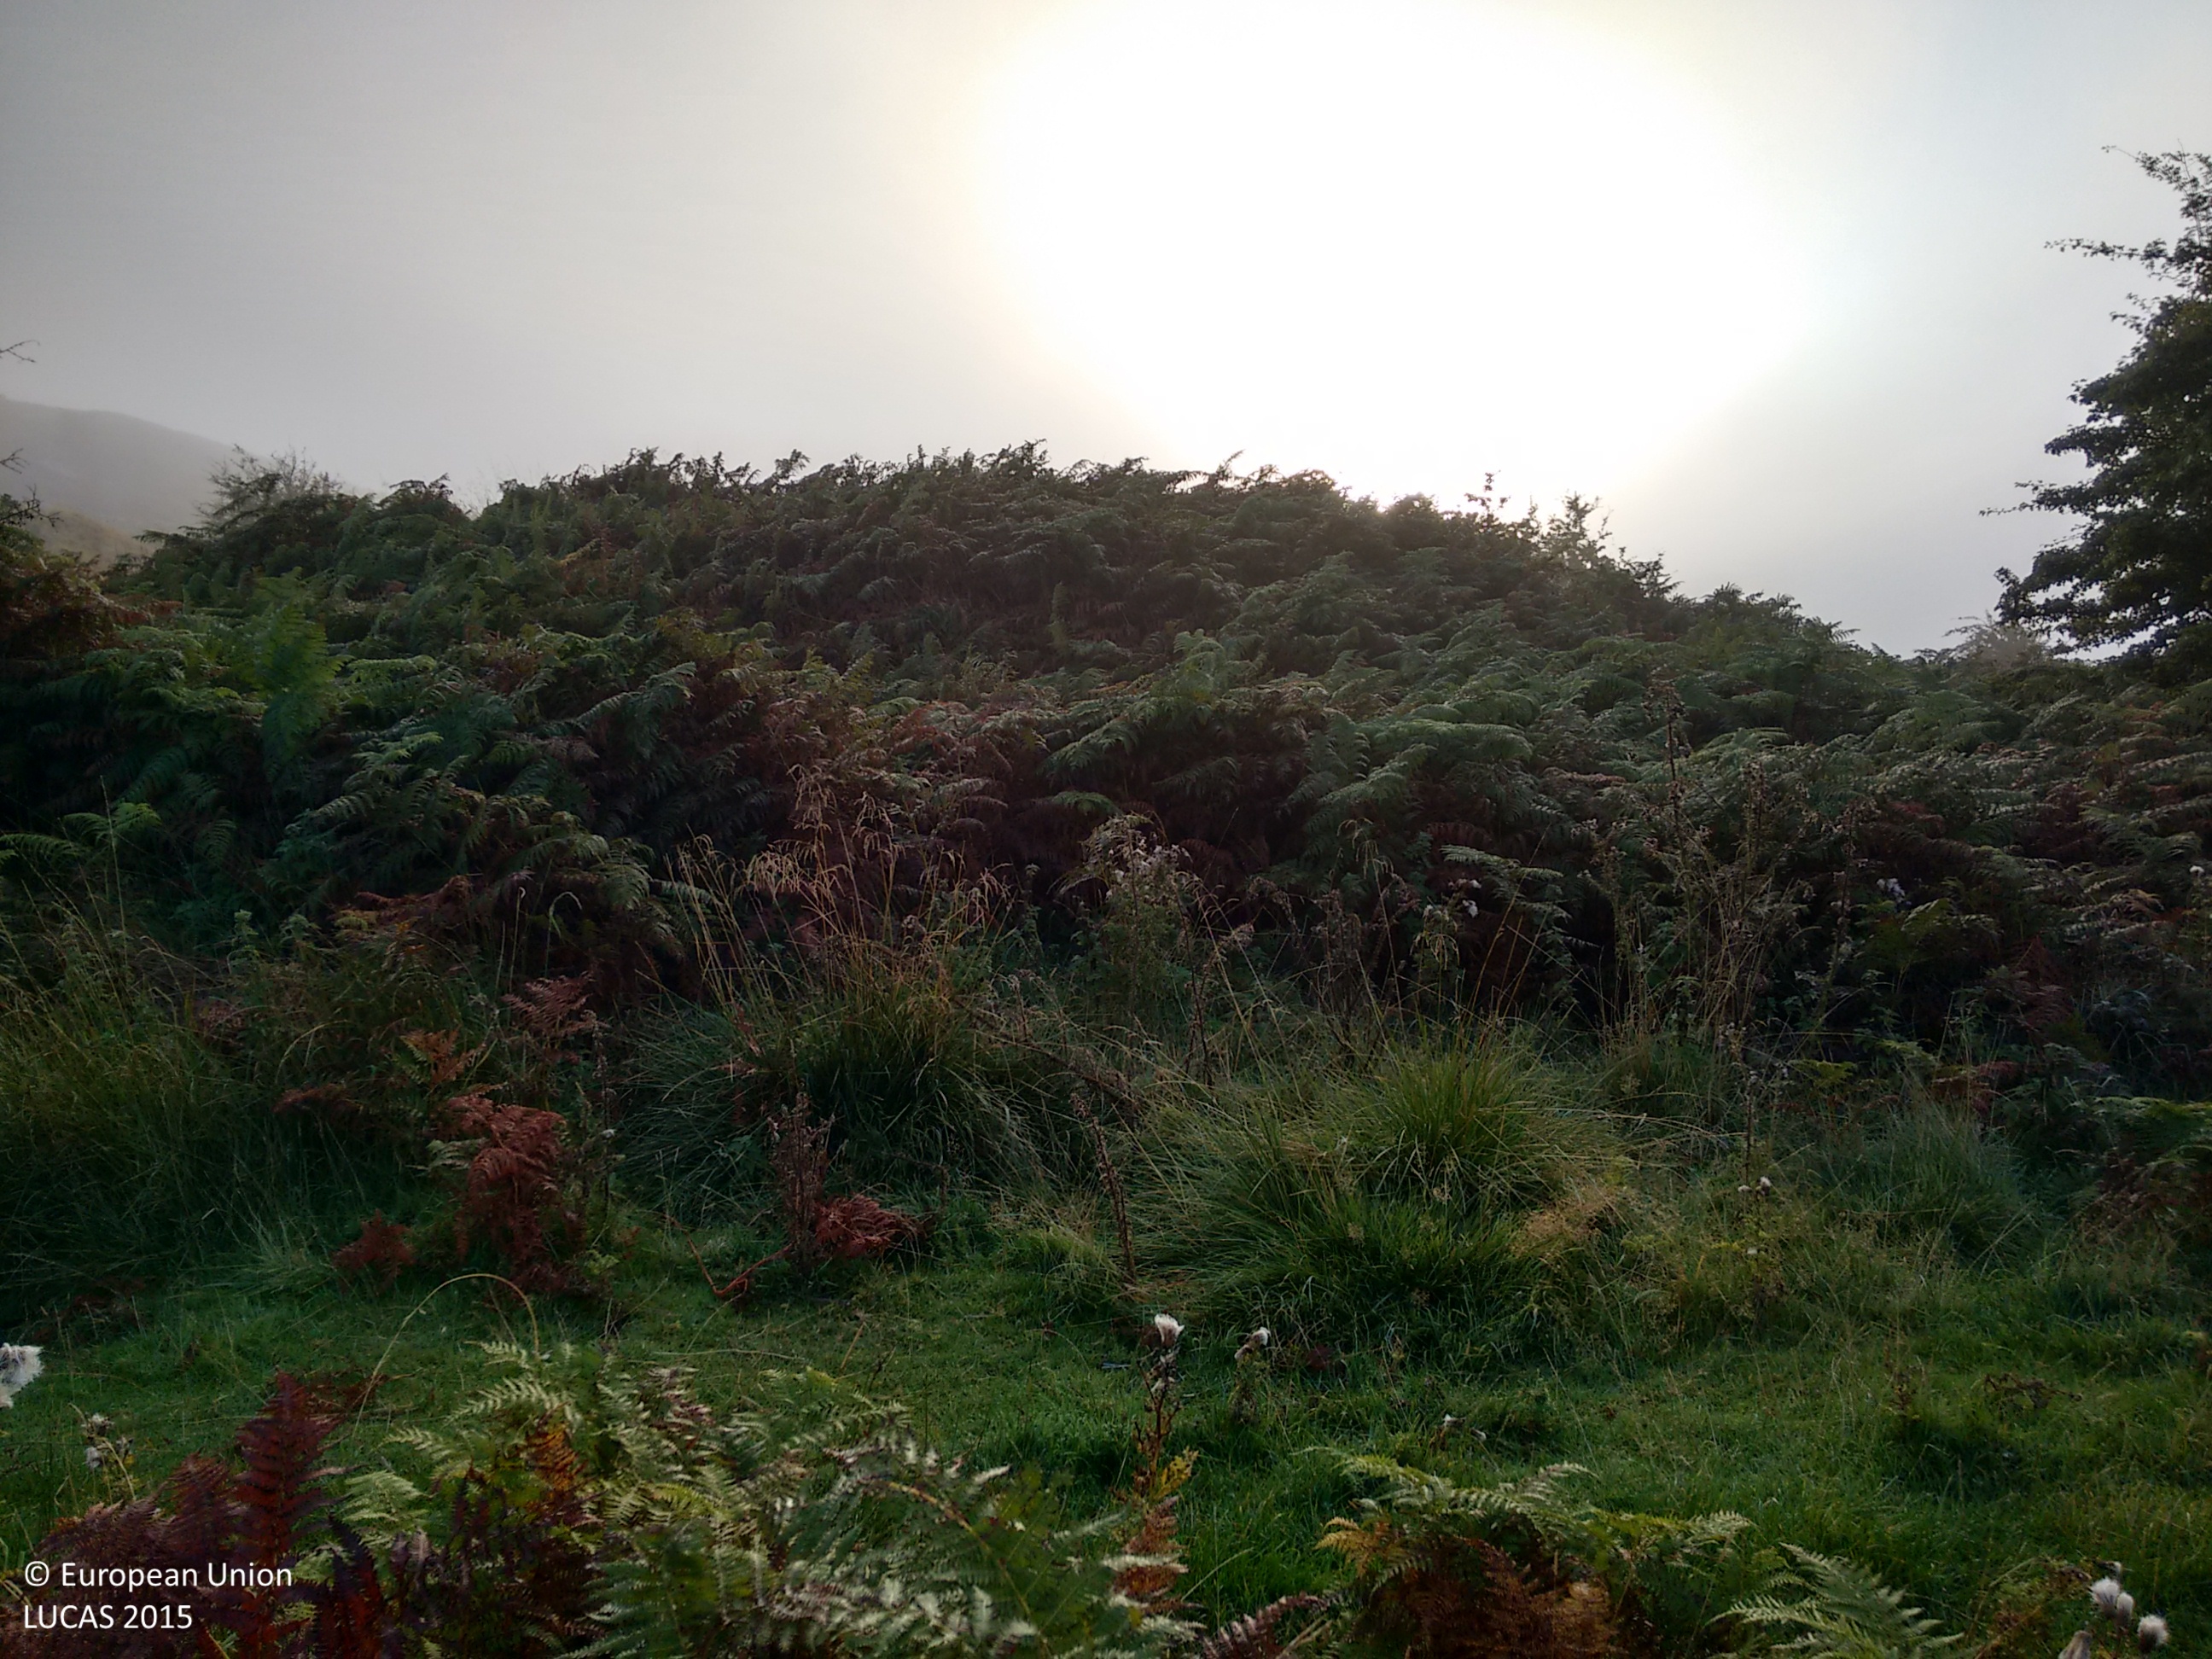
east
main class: Shrubland
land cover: Shrubland with sparse tree cover
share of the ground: > 75 %
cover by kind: herbaceous plants 60 %, shrubs 35 %, broadleaved forest trees 5 %
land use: Agriculture (excluding fallow land and kitchen gardens)
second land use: Community services
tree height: < 5 m
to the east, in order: Shrubland with sparse tree cover; Tracks; Shrubland with sparse tree cover; Grassland without tree/shrub cover; Grassland with sparse tree/shrub cover; Grassland without tree/shrub cover; Tracks; Grassland with sparse tree/shrub cover; Tracks; Grassland with sparse tree/shrub cover; Grassland without tree/shrub cover; Grassland with sparse tree/shrub cover; Rock outcrops
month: September
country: GB
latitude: 51.9270
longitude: -2.0270
